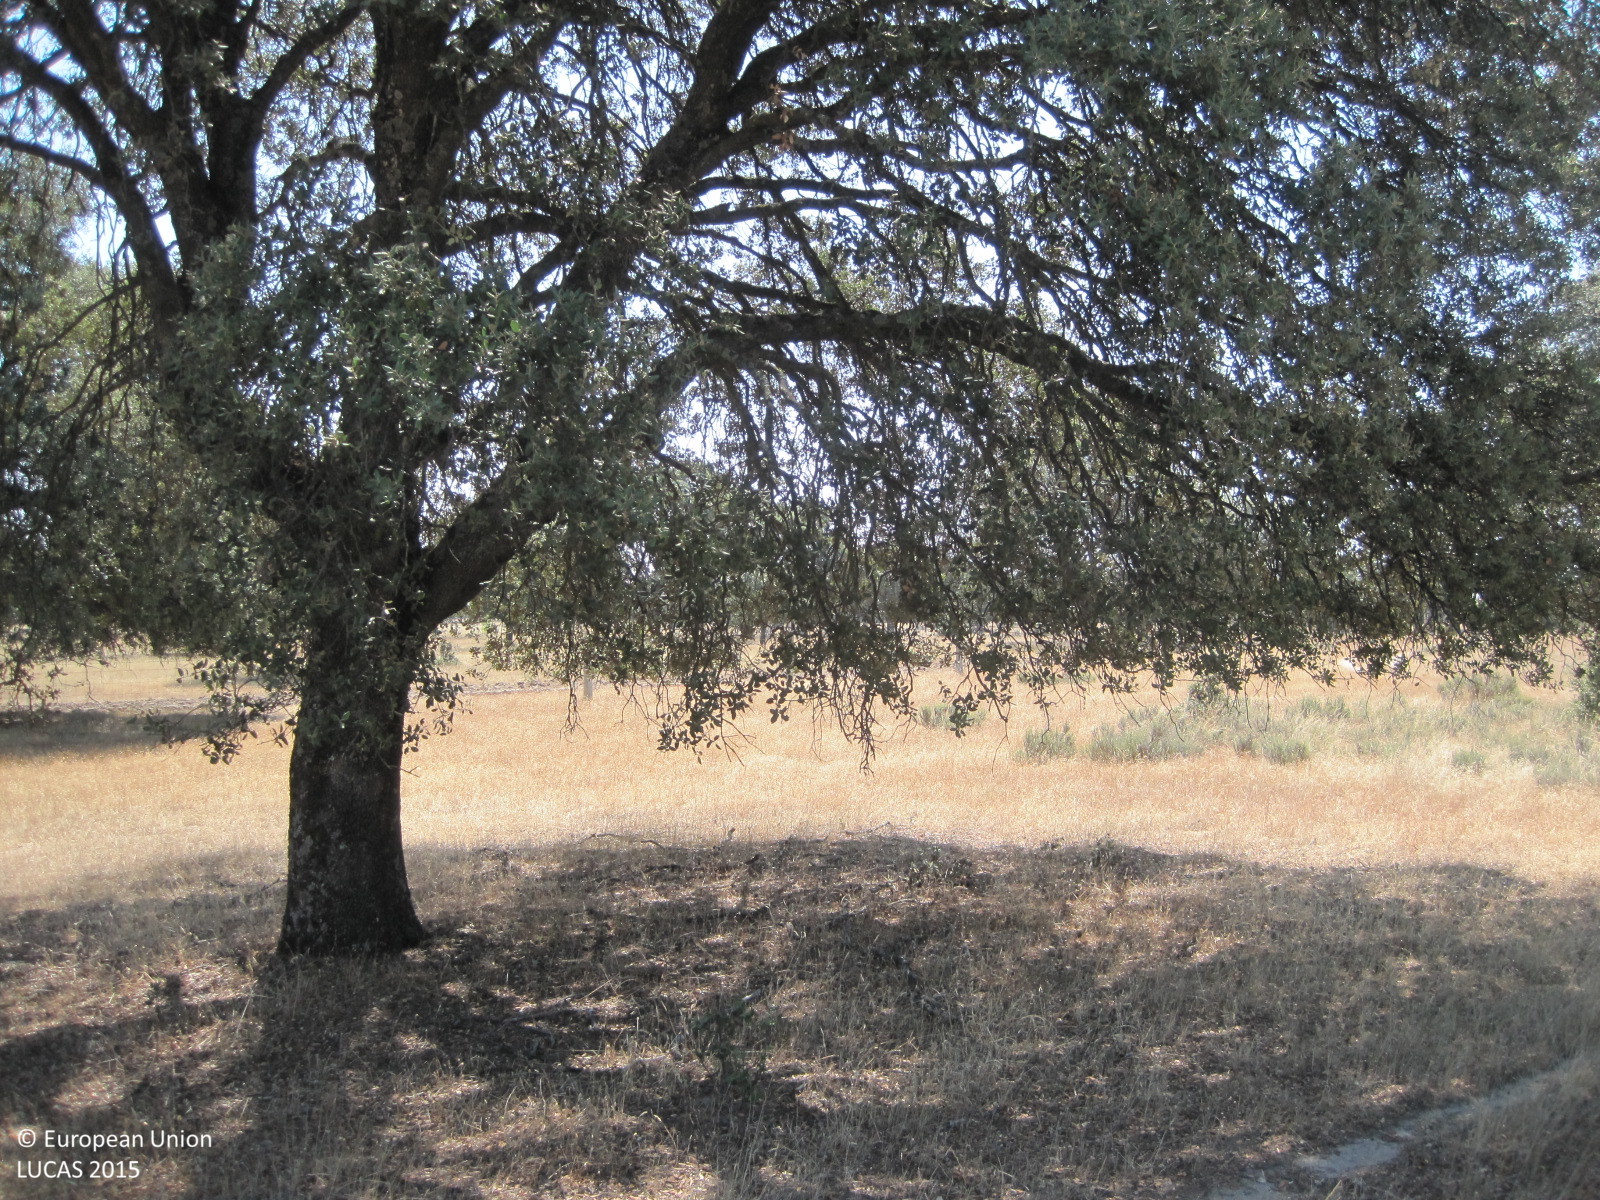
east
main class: Woodland
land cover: Broadleaved woodland
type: broadleaved evergreen forest
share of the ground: 50 - 75 %
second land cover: Grassland without tree/shrub cover
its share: > 75 %
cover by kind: broadleaved forest trees 50 %, herbaceous plants 50 %
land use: Forestry
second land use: Agriculture (excluding fallow land and kitchen gardens)
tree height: > 5 m
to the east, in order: Broadleaved woodland; Grassland without tree/shrub cover; Fences; Broadleaved woodland; Fences; Tracks; Fences; Broadleaved woodland
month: July
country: ES
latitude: 39.9731
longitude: -5.0980
